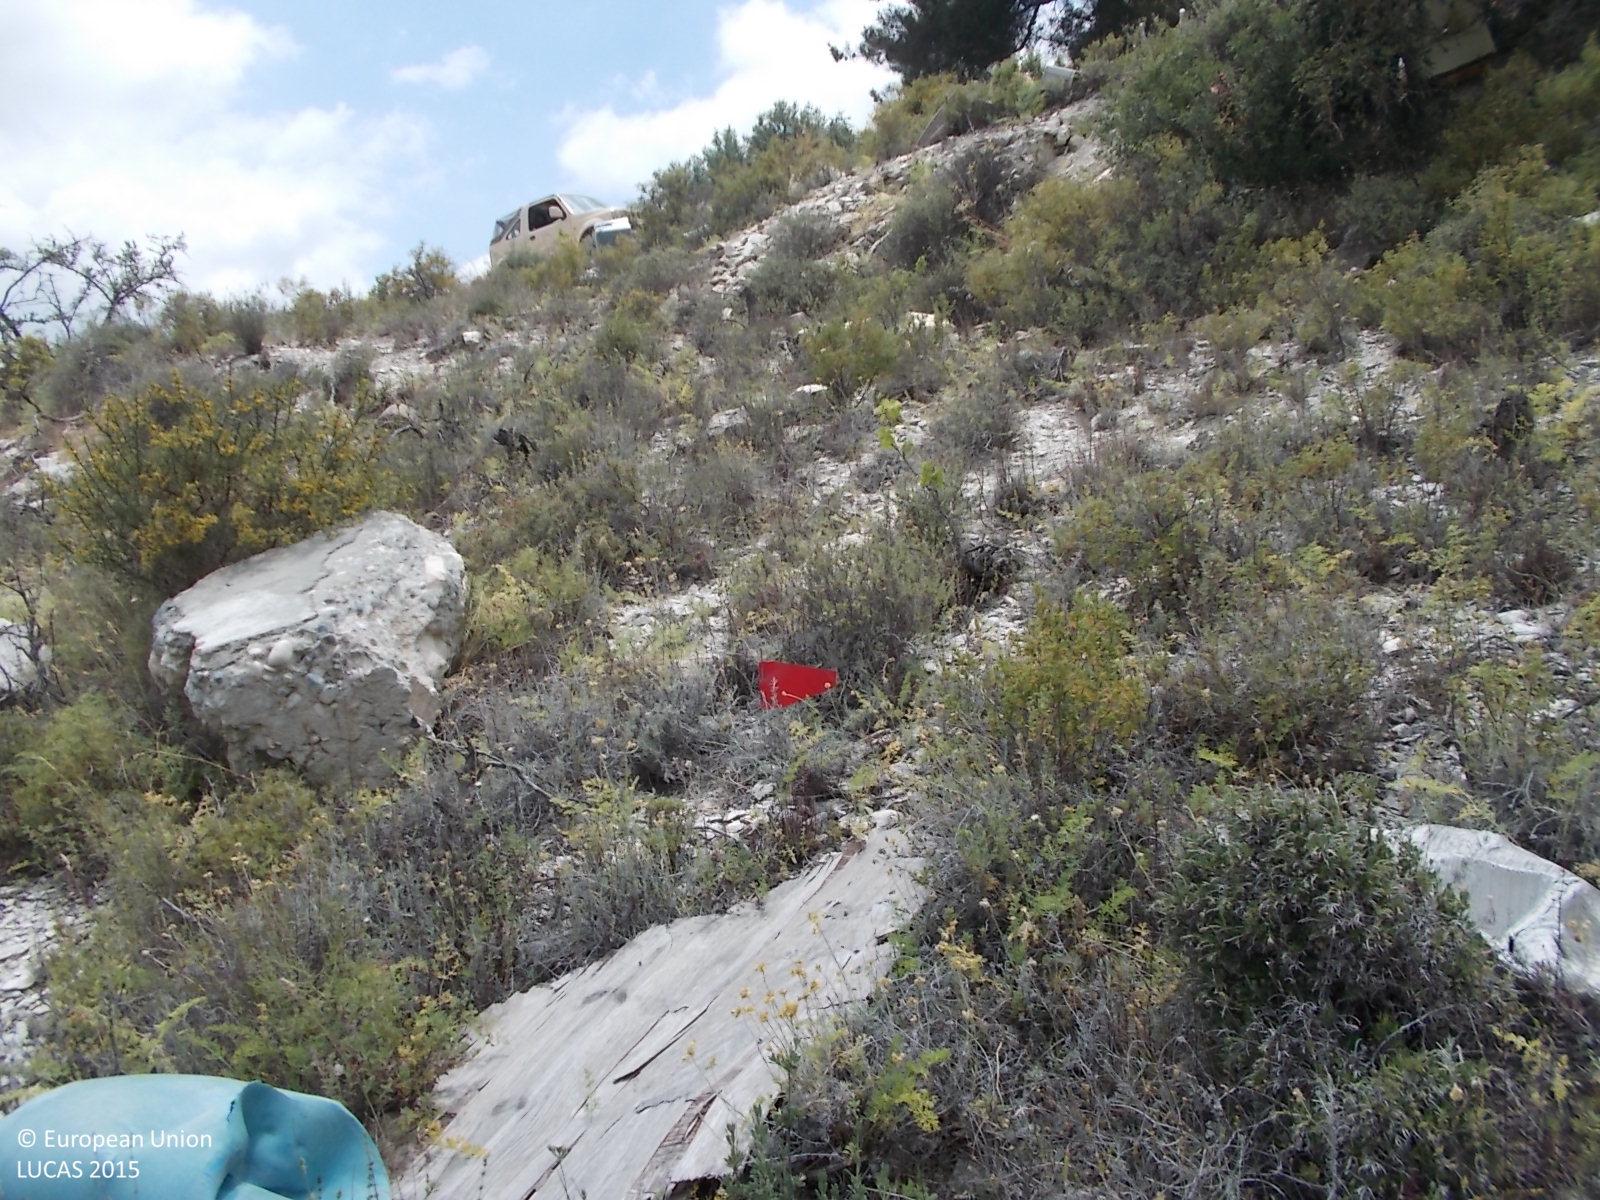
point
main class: Shrubland
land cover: Shrubland without tree cover
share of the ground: 50 - 75 %
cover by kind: shrubs 75 %, consolidated bare surface 15 %, unconsolidated bare surface 10 %
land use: Semi-natural and natural areas not in use
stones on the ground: 25 - 50 %
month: June
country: CY
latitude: 34.8598
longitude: 32.8149
